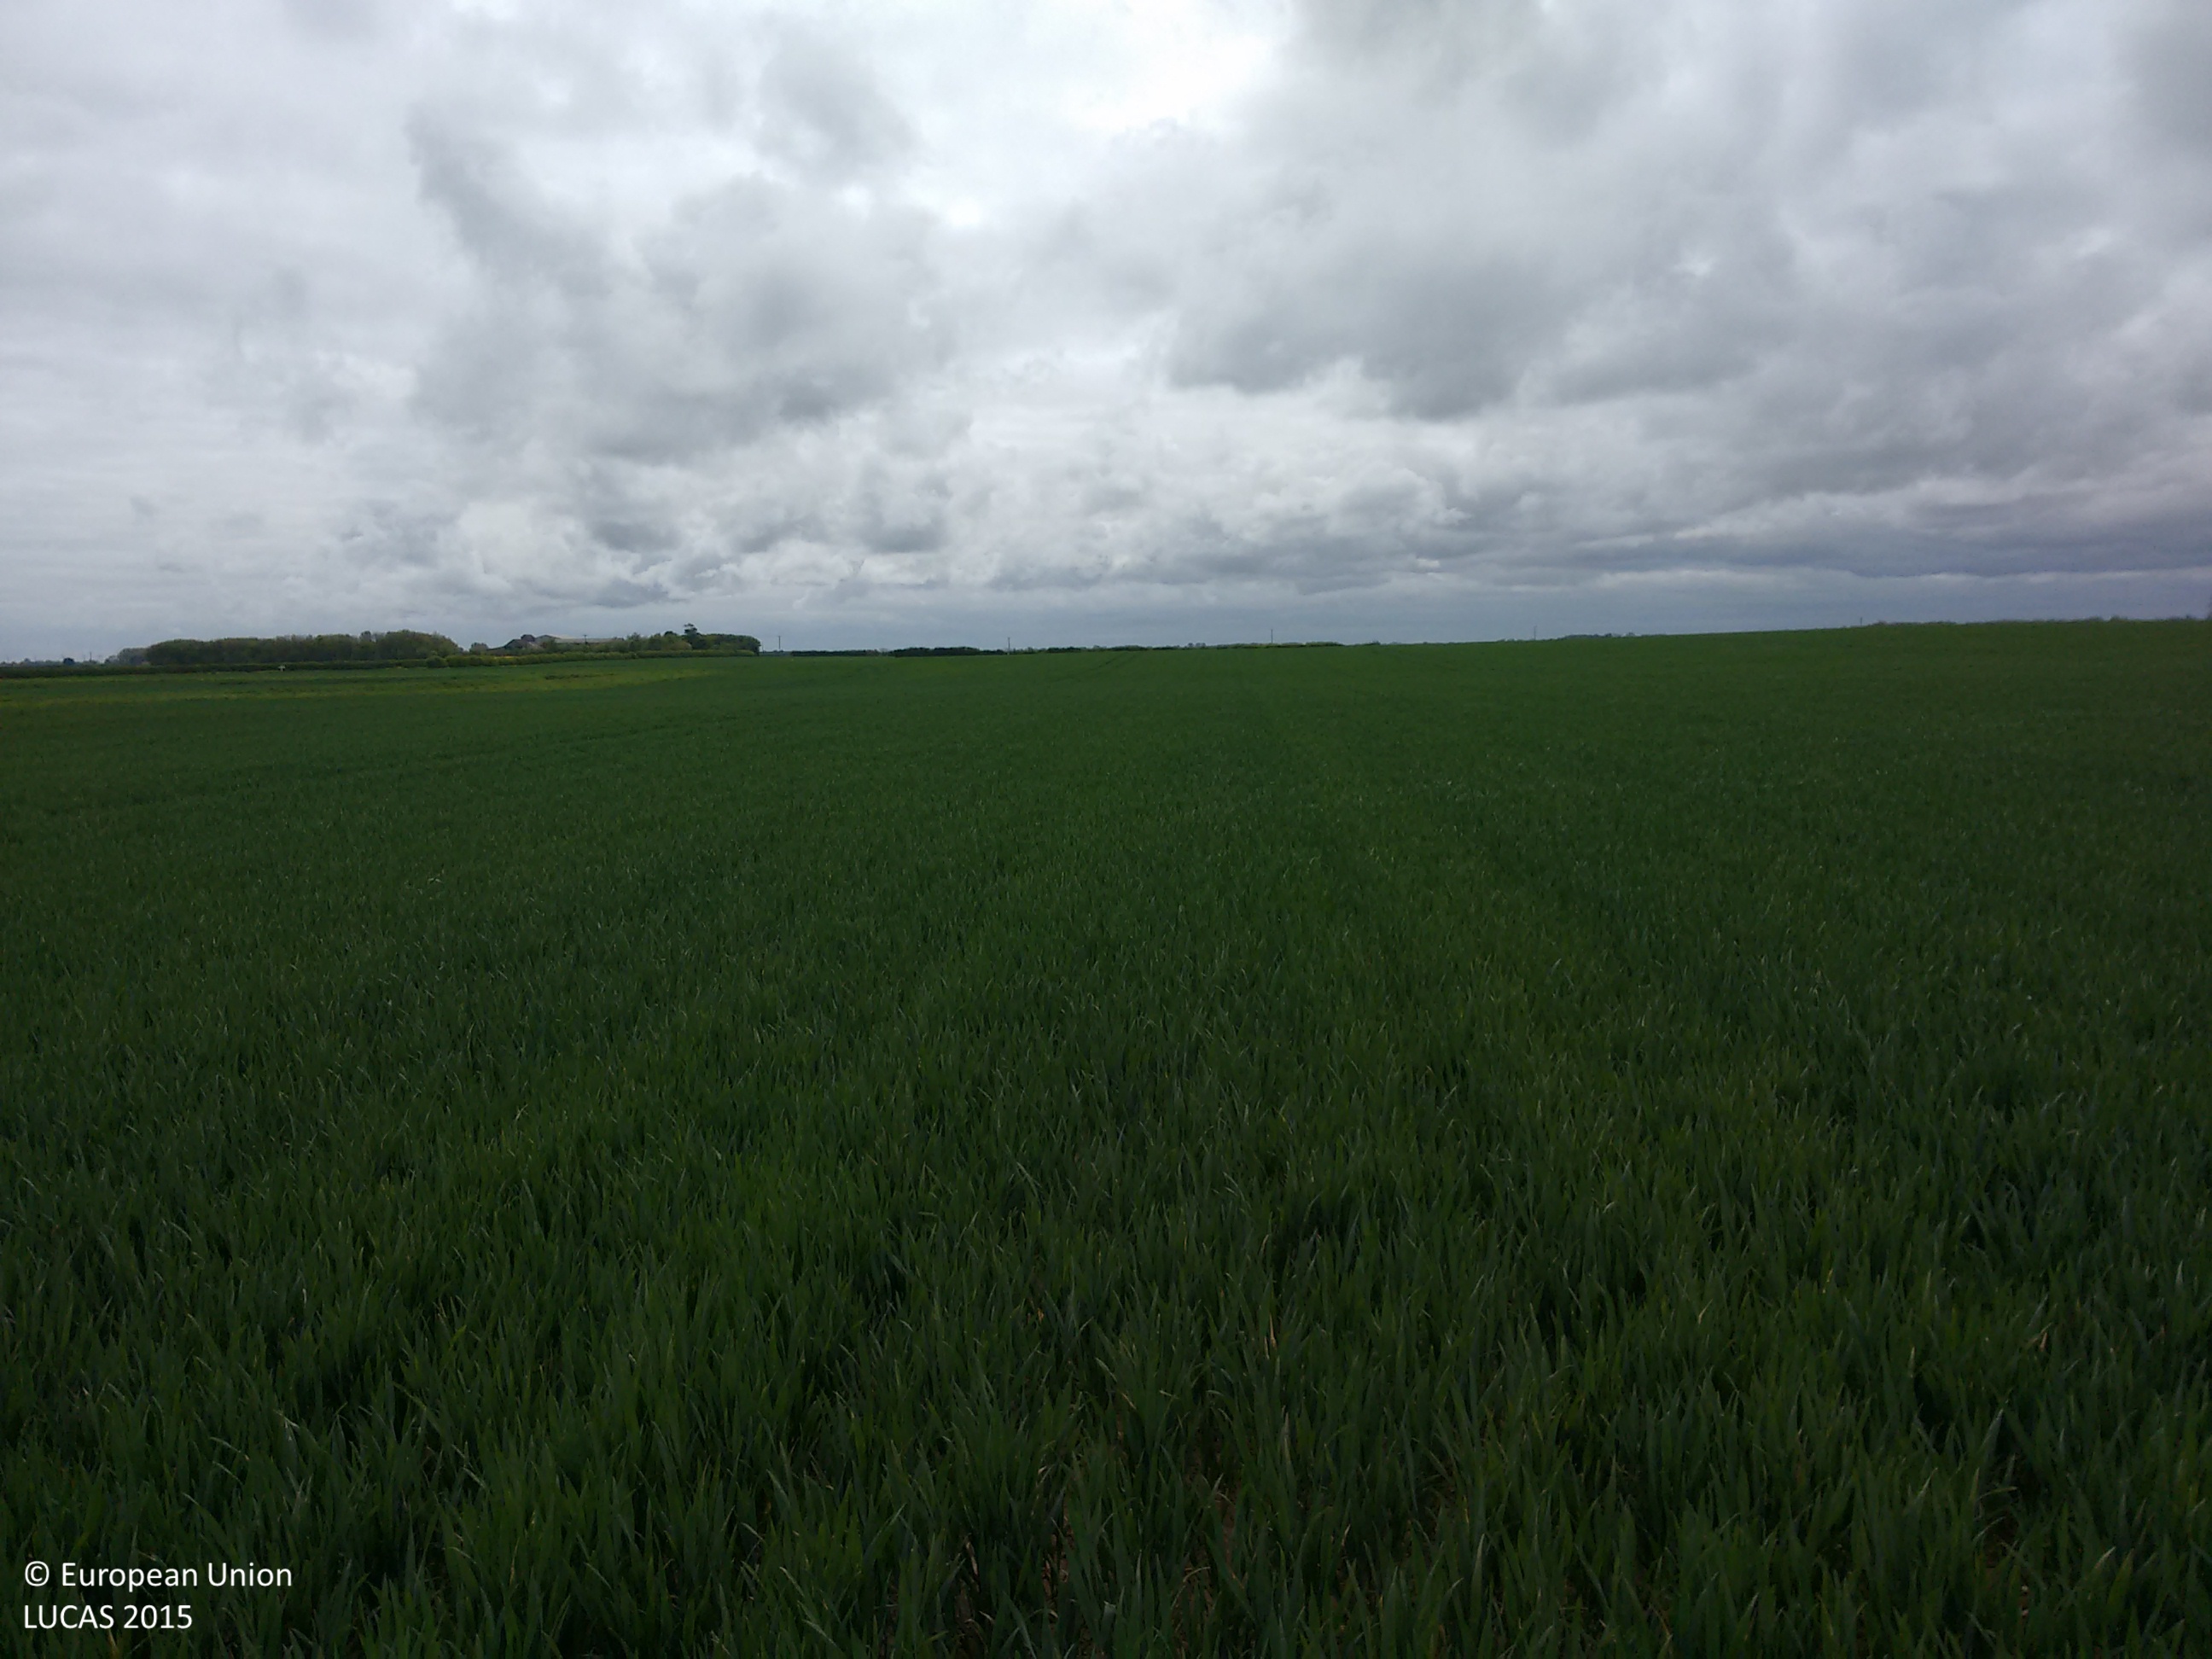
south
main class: Cropland
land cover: Common wheat
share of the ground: > 75 %
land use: Agriculture (excluding fallow land and kitchen gardens)
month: May
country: GB
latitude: 53.8249
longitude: -0.1661
